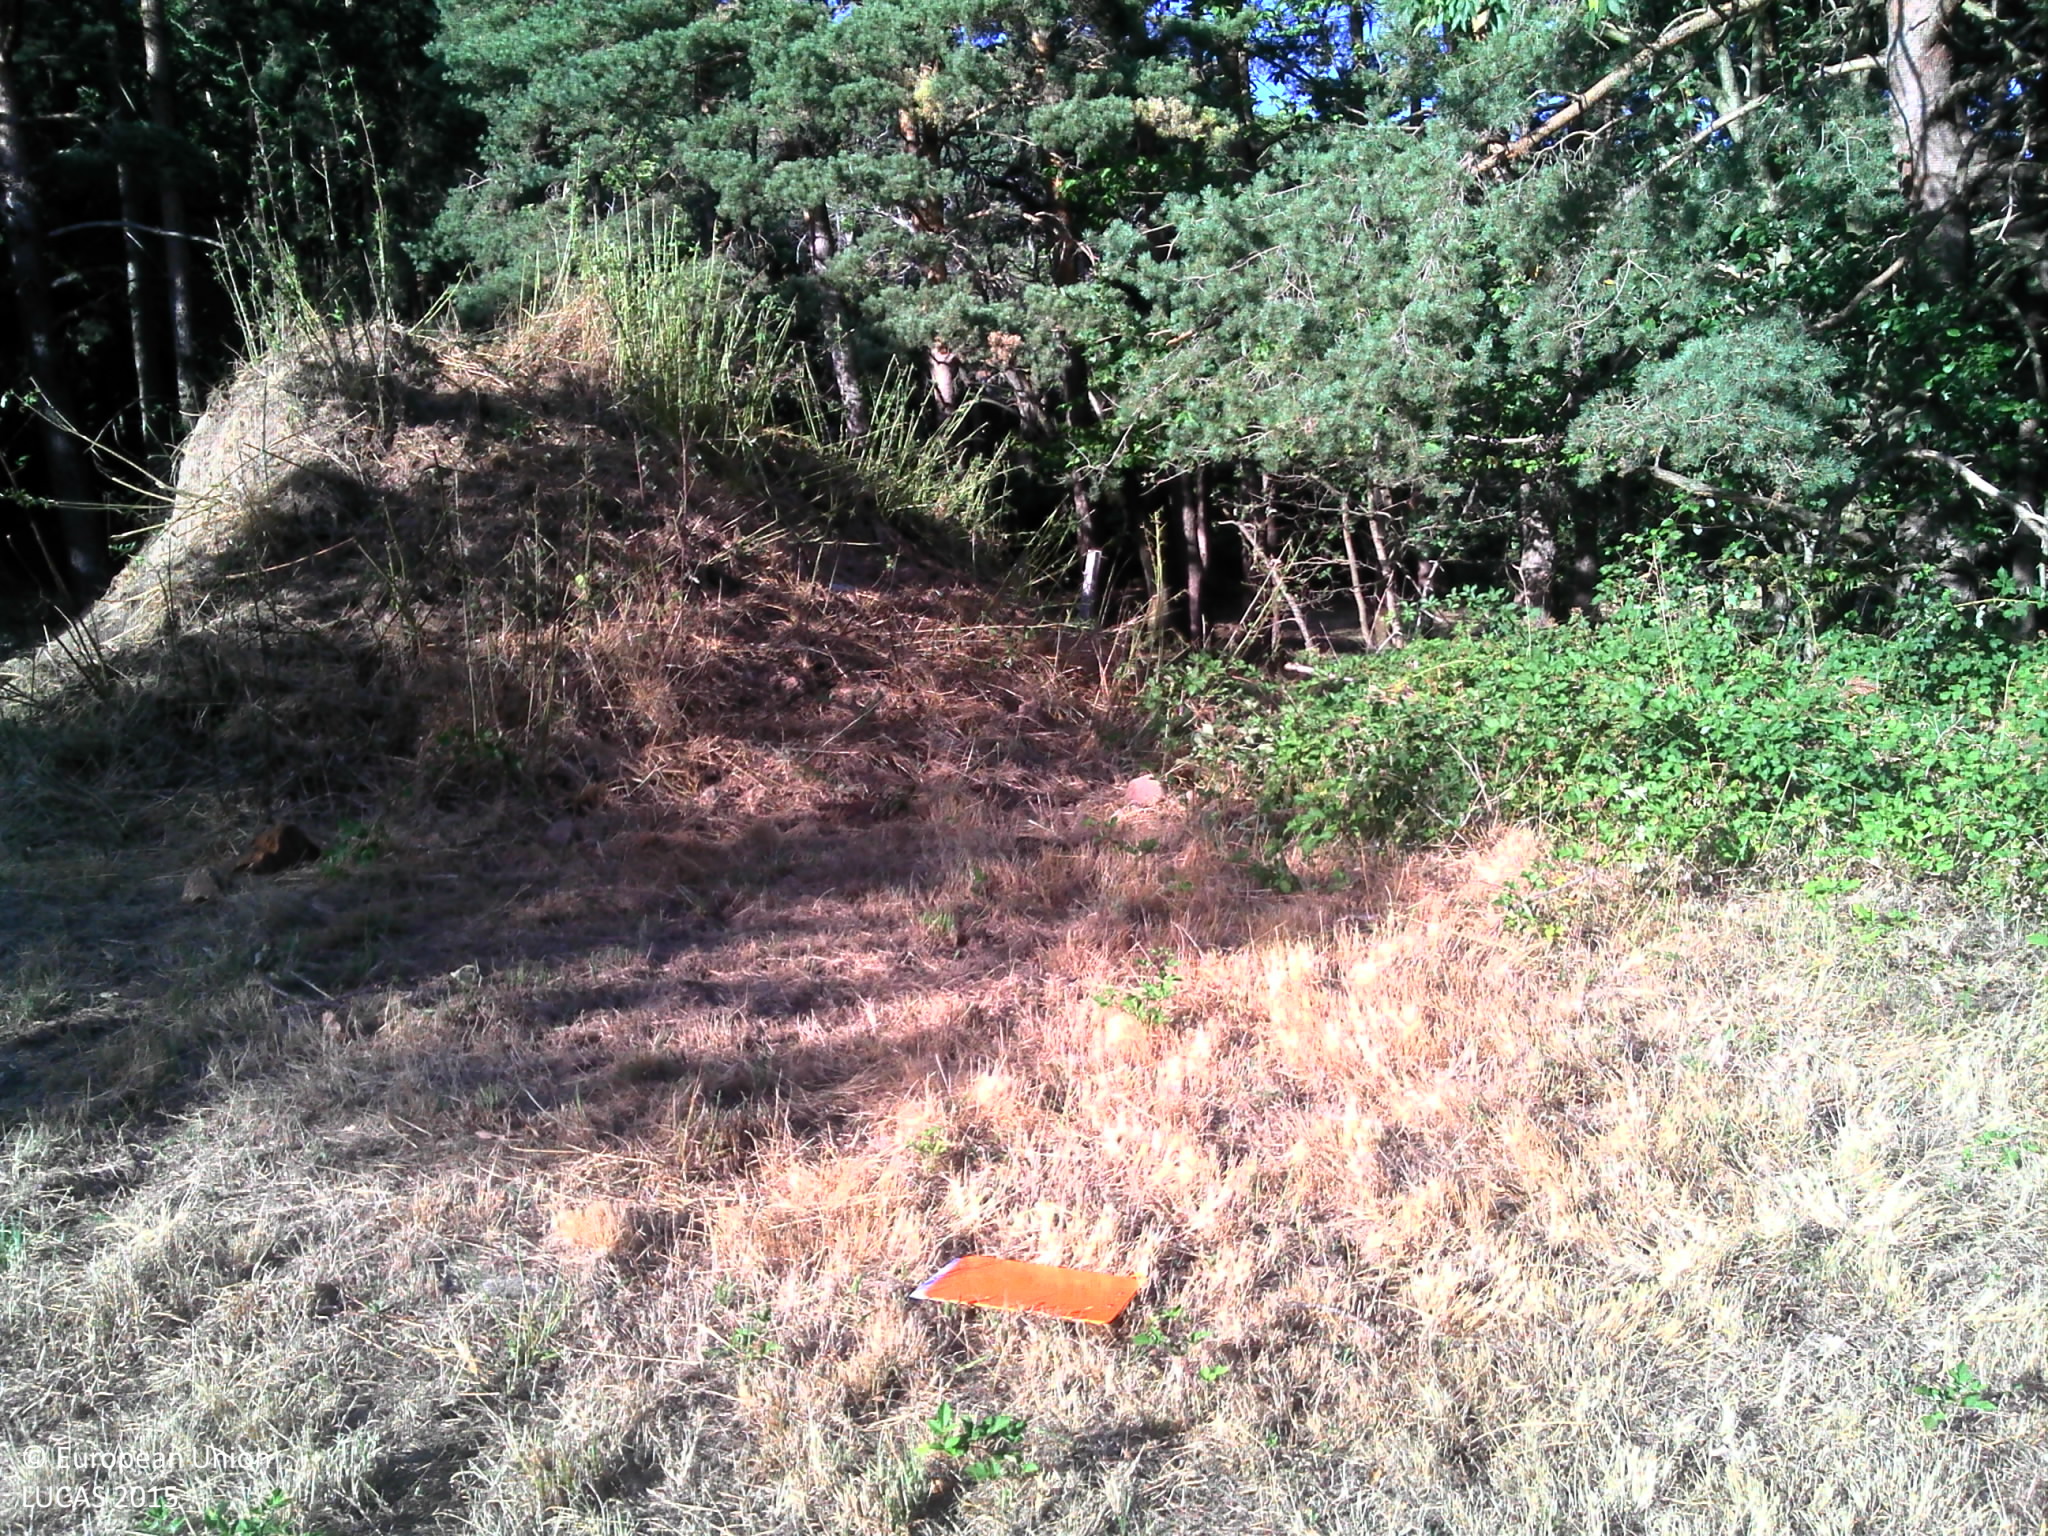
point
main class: Grassland
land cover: Grassland with sparse tree/shrub cover
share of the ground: > 75 %
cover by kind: herbaceous plants 95 %, broadleaved forest trees 5 %
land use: Agriculture (excluding fallow land and kitchen gardens)
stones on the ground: < 10 %
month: July
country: FR
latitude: 44.9338
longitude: 4.6202
